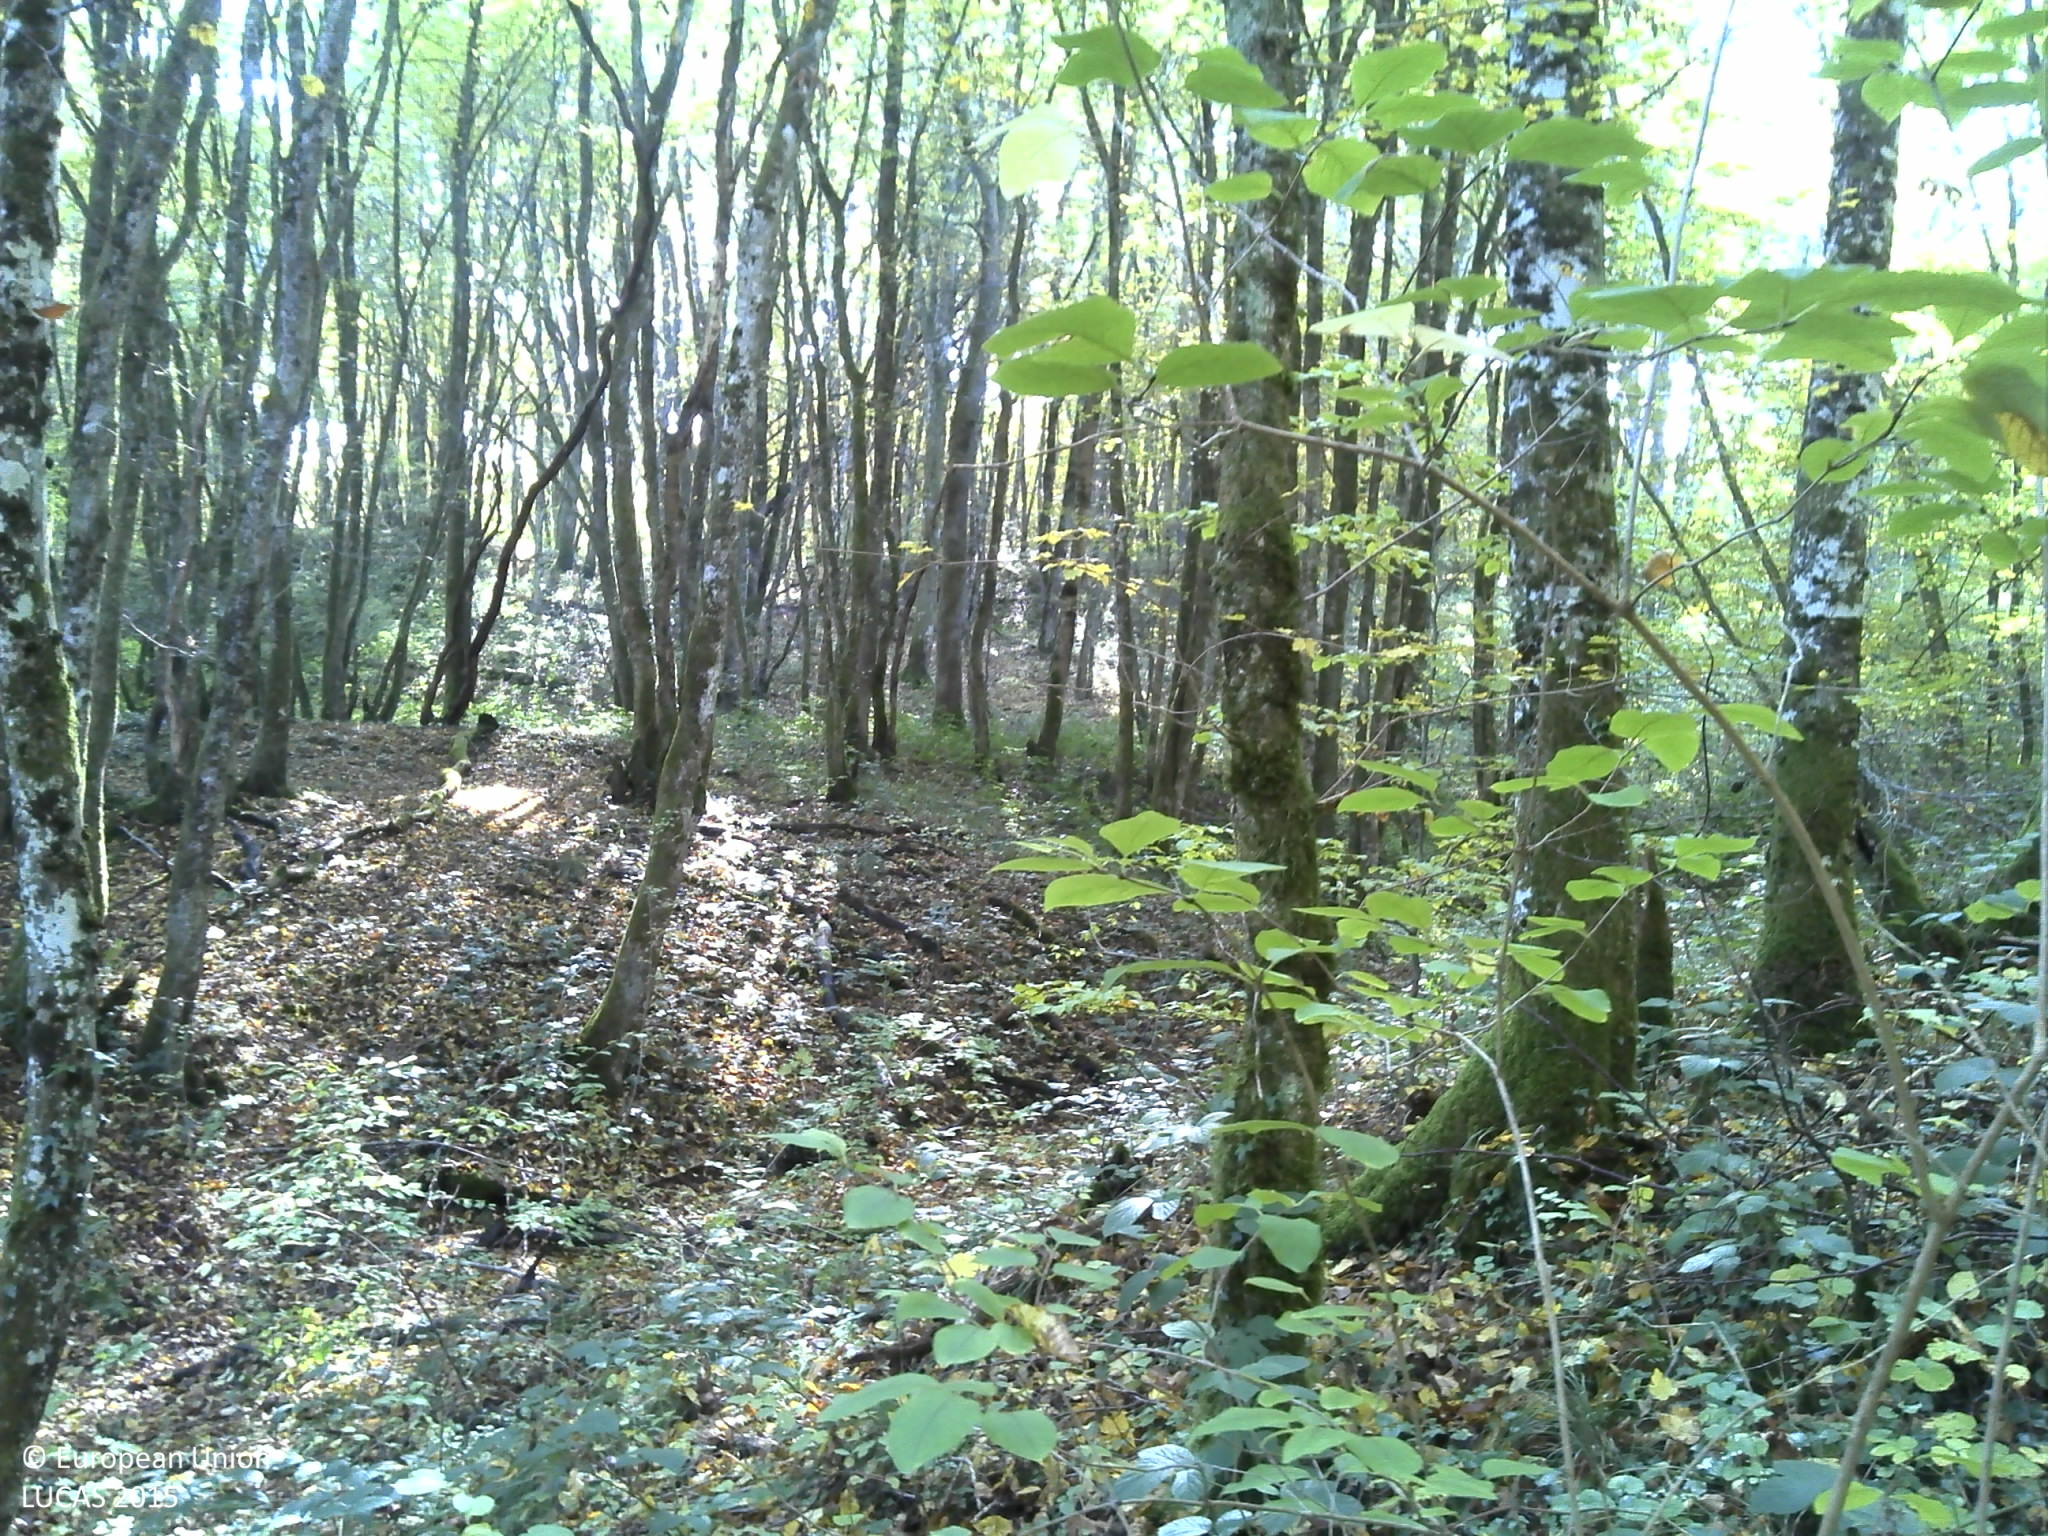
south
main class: Woodland
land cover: Broadleaved woodland
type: mesophytic deciduous forest
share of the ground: > 75 %
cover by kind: broadleaved forest trees 90 %, lichens and mosses 5 %, unconsolidated bare surface 5 %
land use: Forestry
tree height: > 5 m
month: October
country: FR
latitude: 45.8916
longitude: 5.4030
